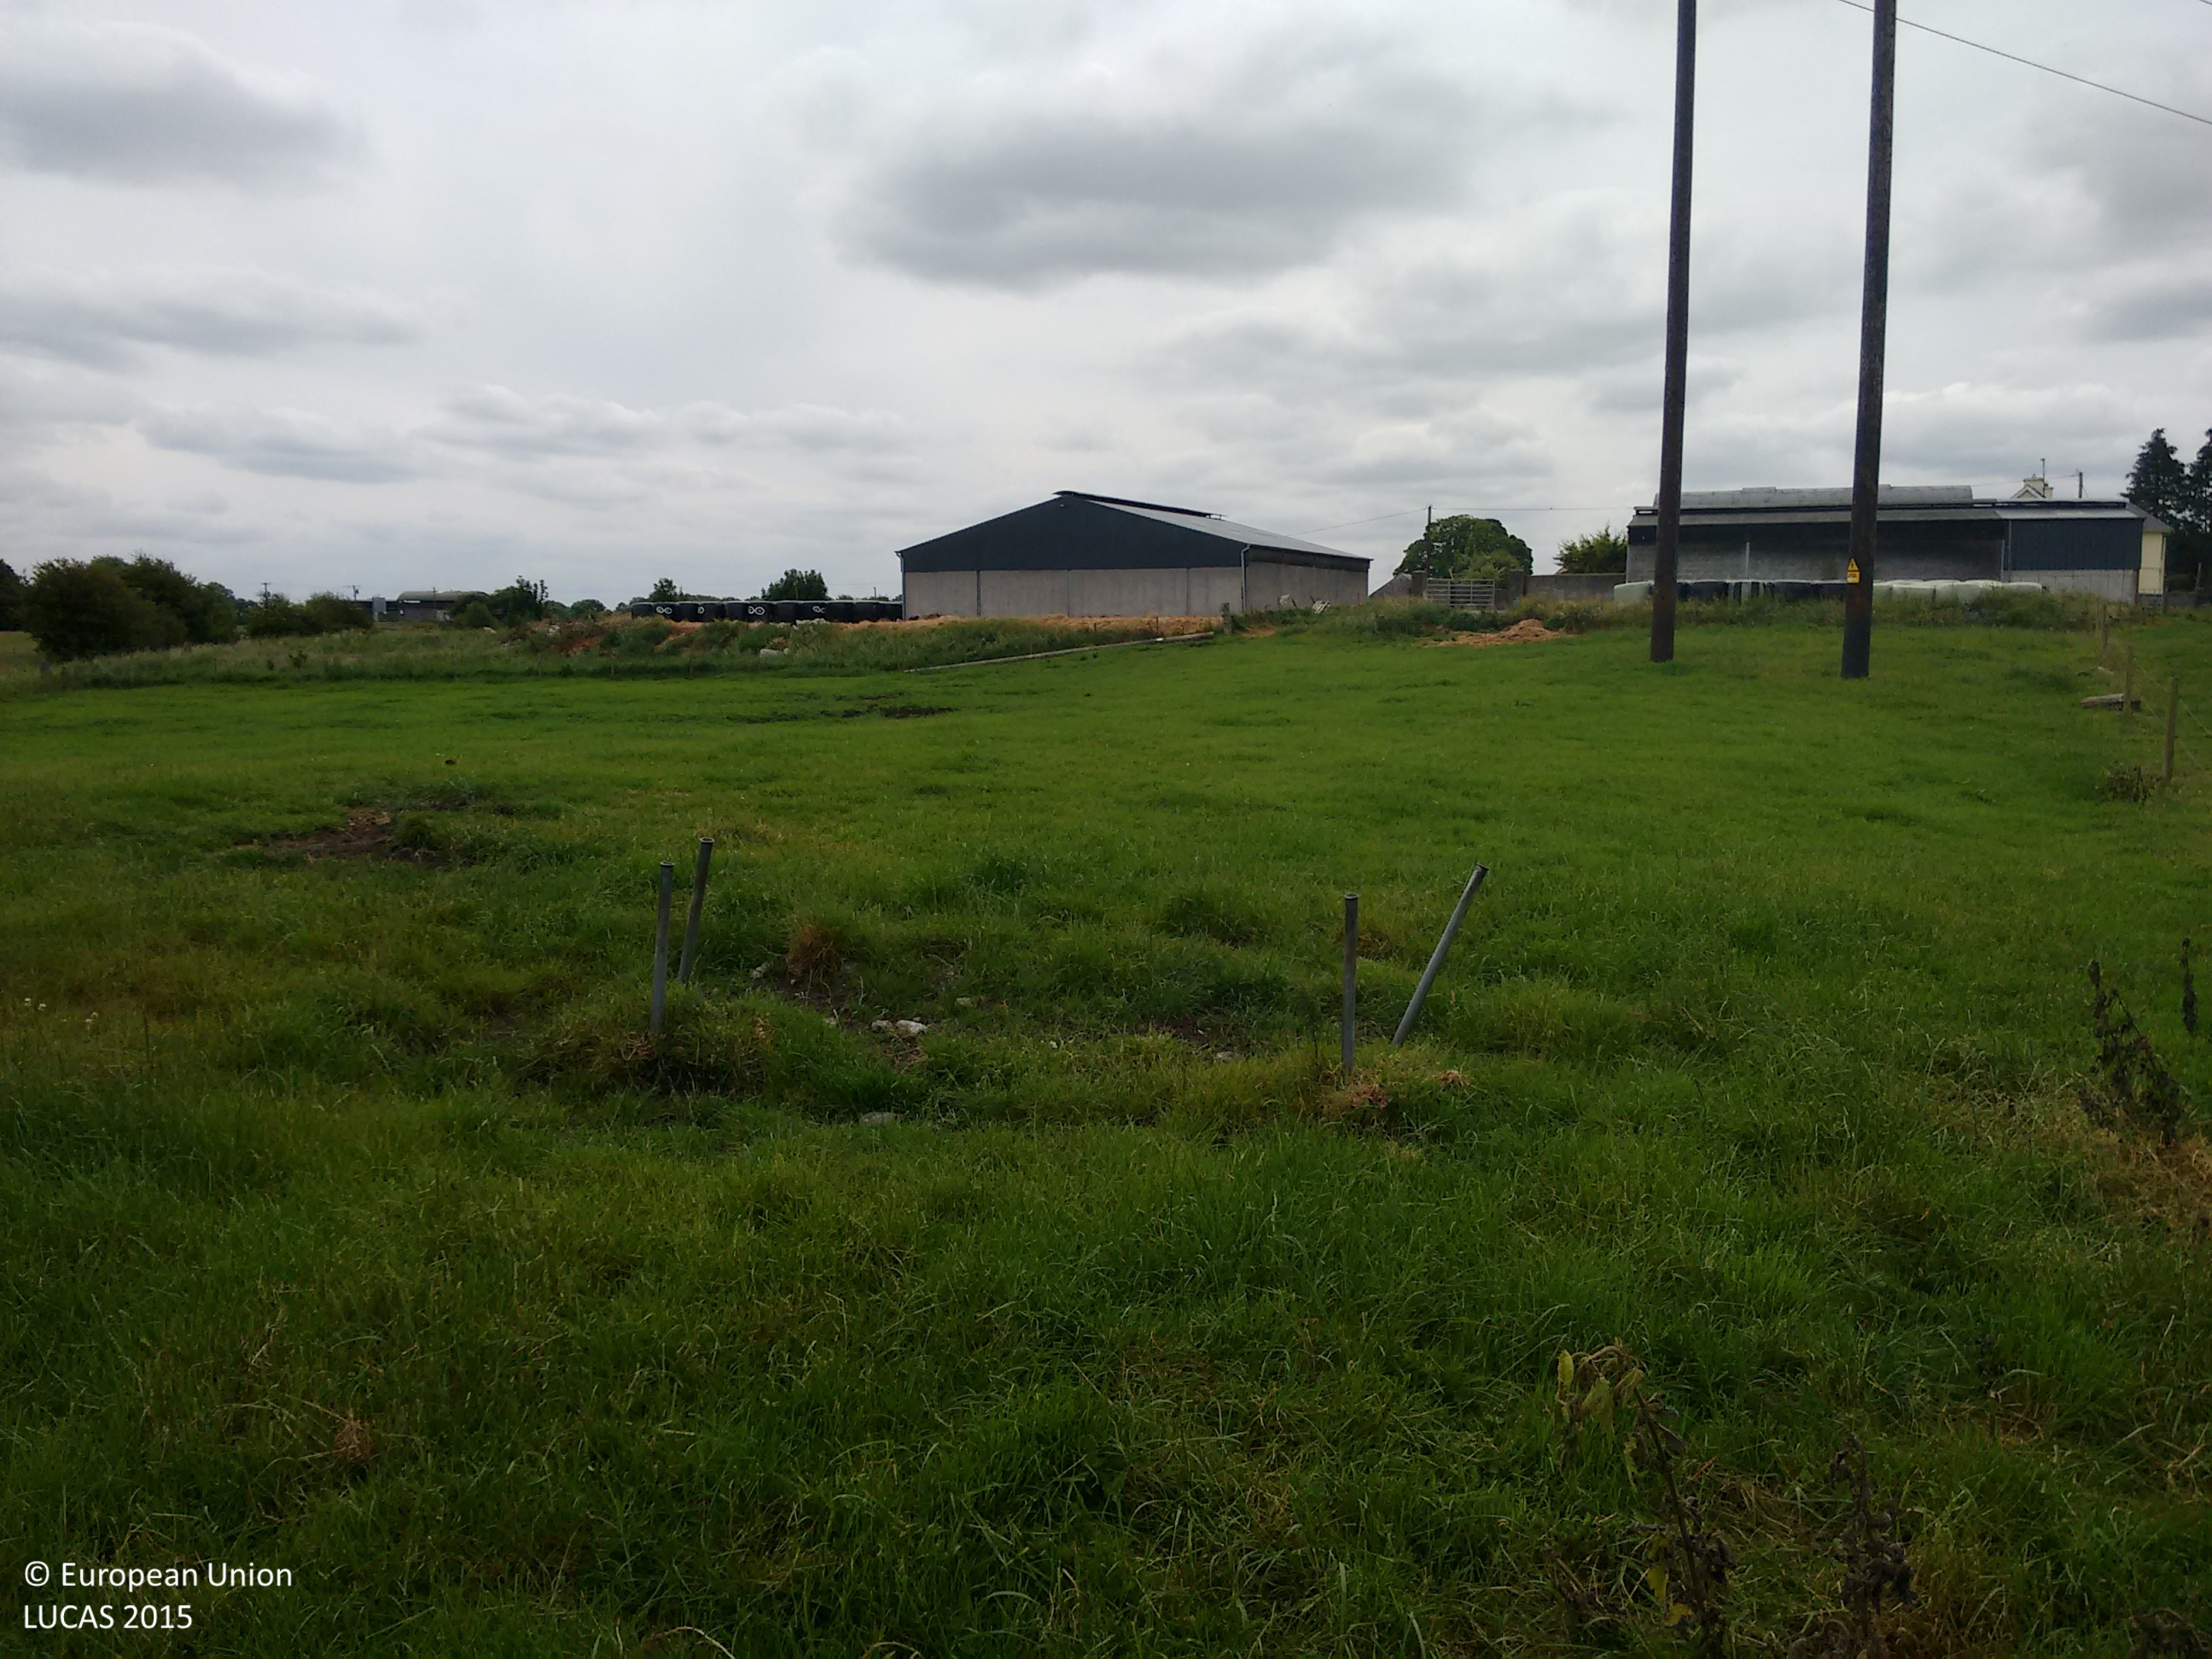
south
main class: Grassland
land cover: Grassland without tree/shrub cover
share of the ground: > 75 %
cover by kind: herbaceous plants 100 %
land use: Agriculture (excluding fallow land and kitchen gardens)
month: July
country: IE
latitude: 53.3587
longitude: -8.0421
